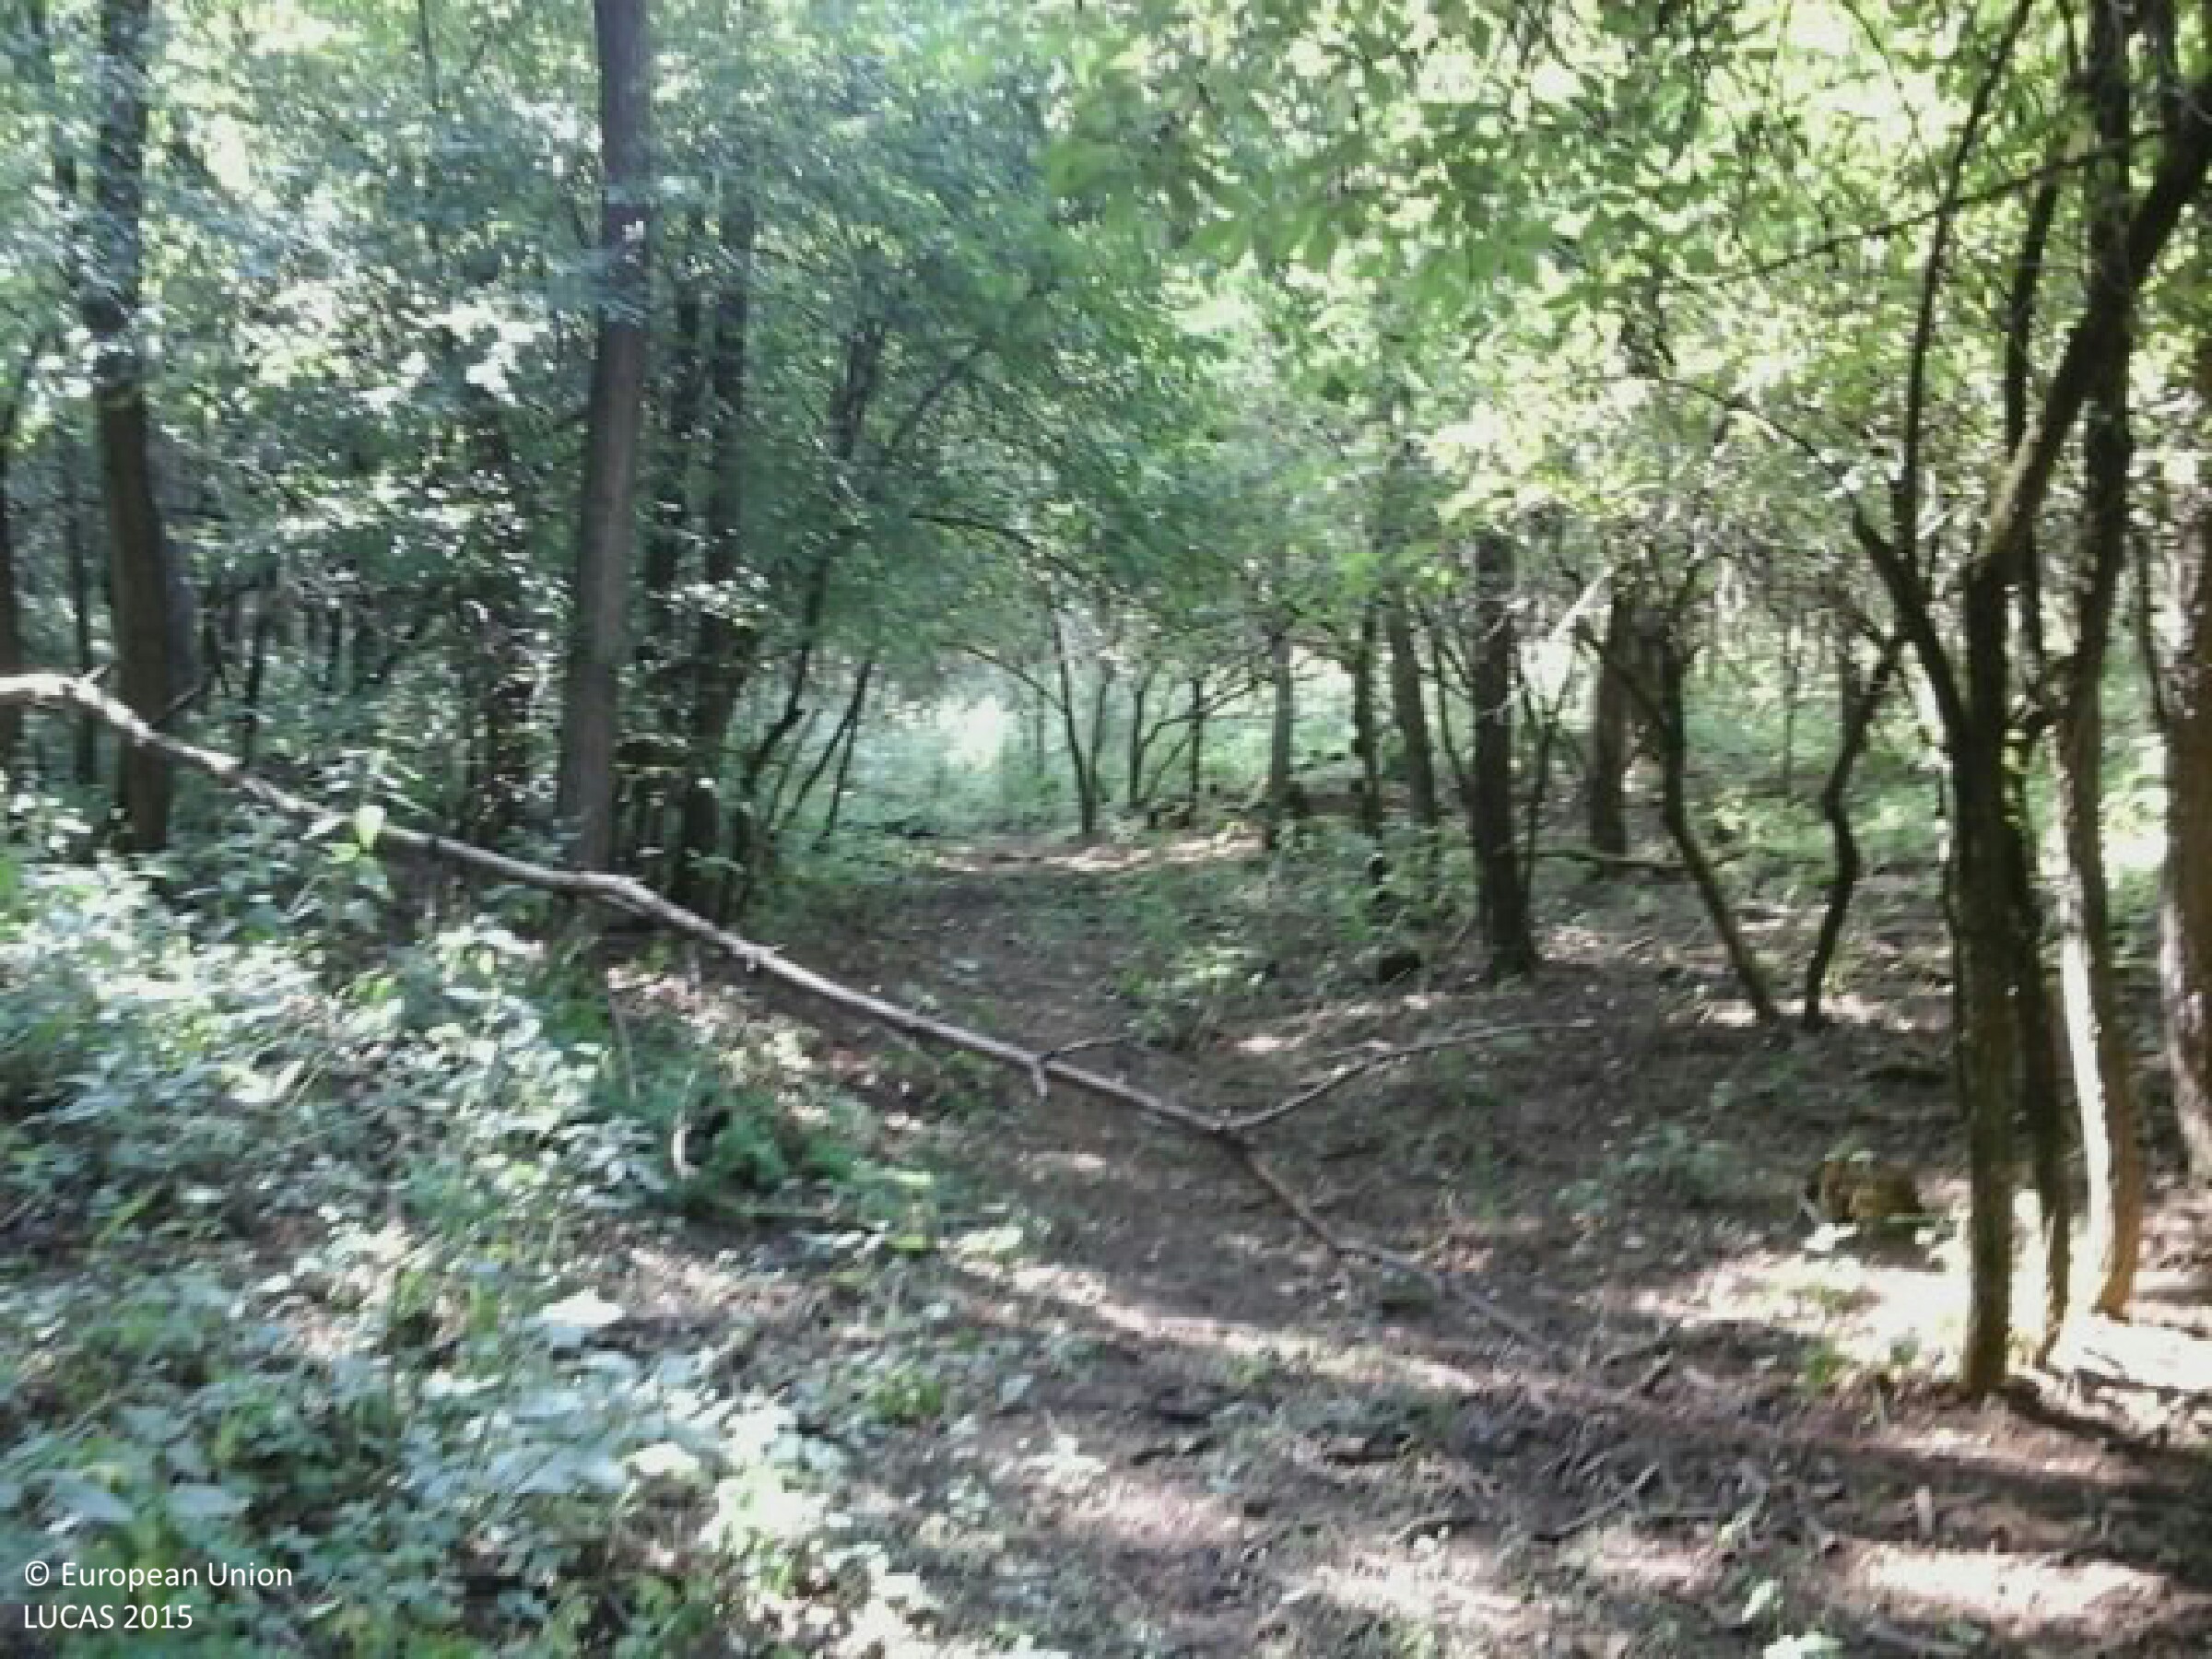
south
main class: Woodland
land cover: Broadleaved woodland
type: mesophytic deciduous forest
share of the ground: > 75 %
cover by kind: broadleaved forest trees 90 %, herbaceous plants 10 %
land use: Forestry
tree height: > 5 m
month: August
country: HU
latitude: 48.0046
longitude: 19.9869
